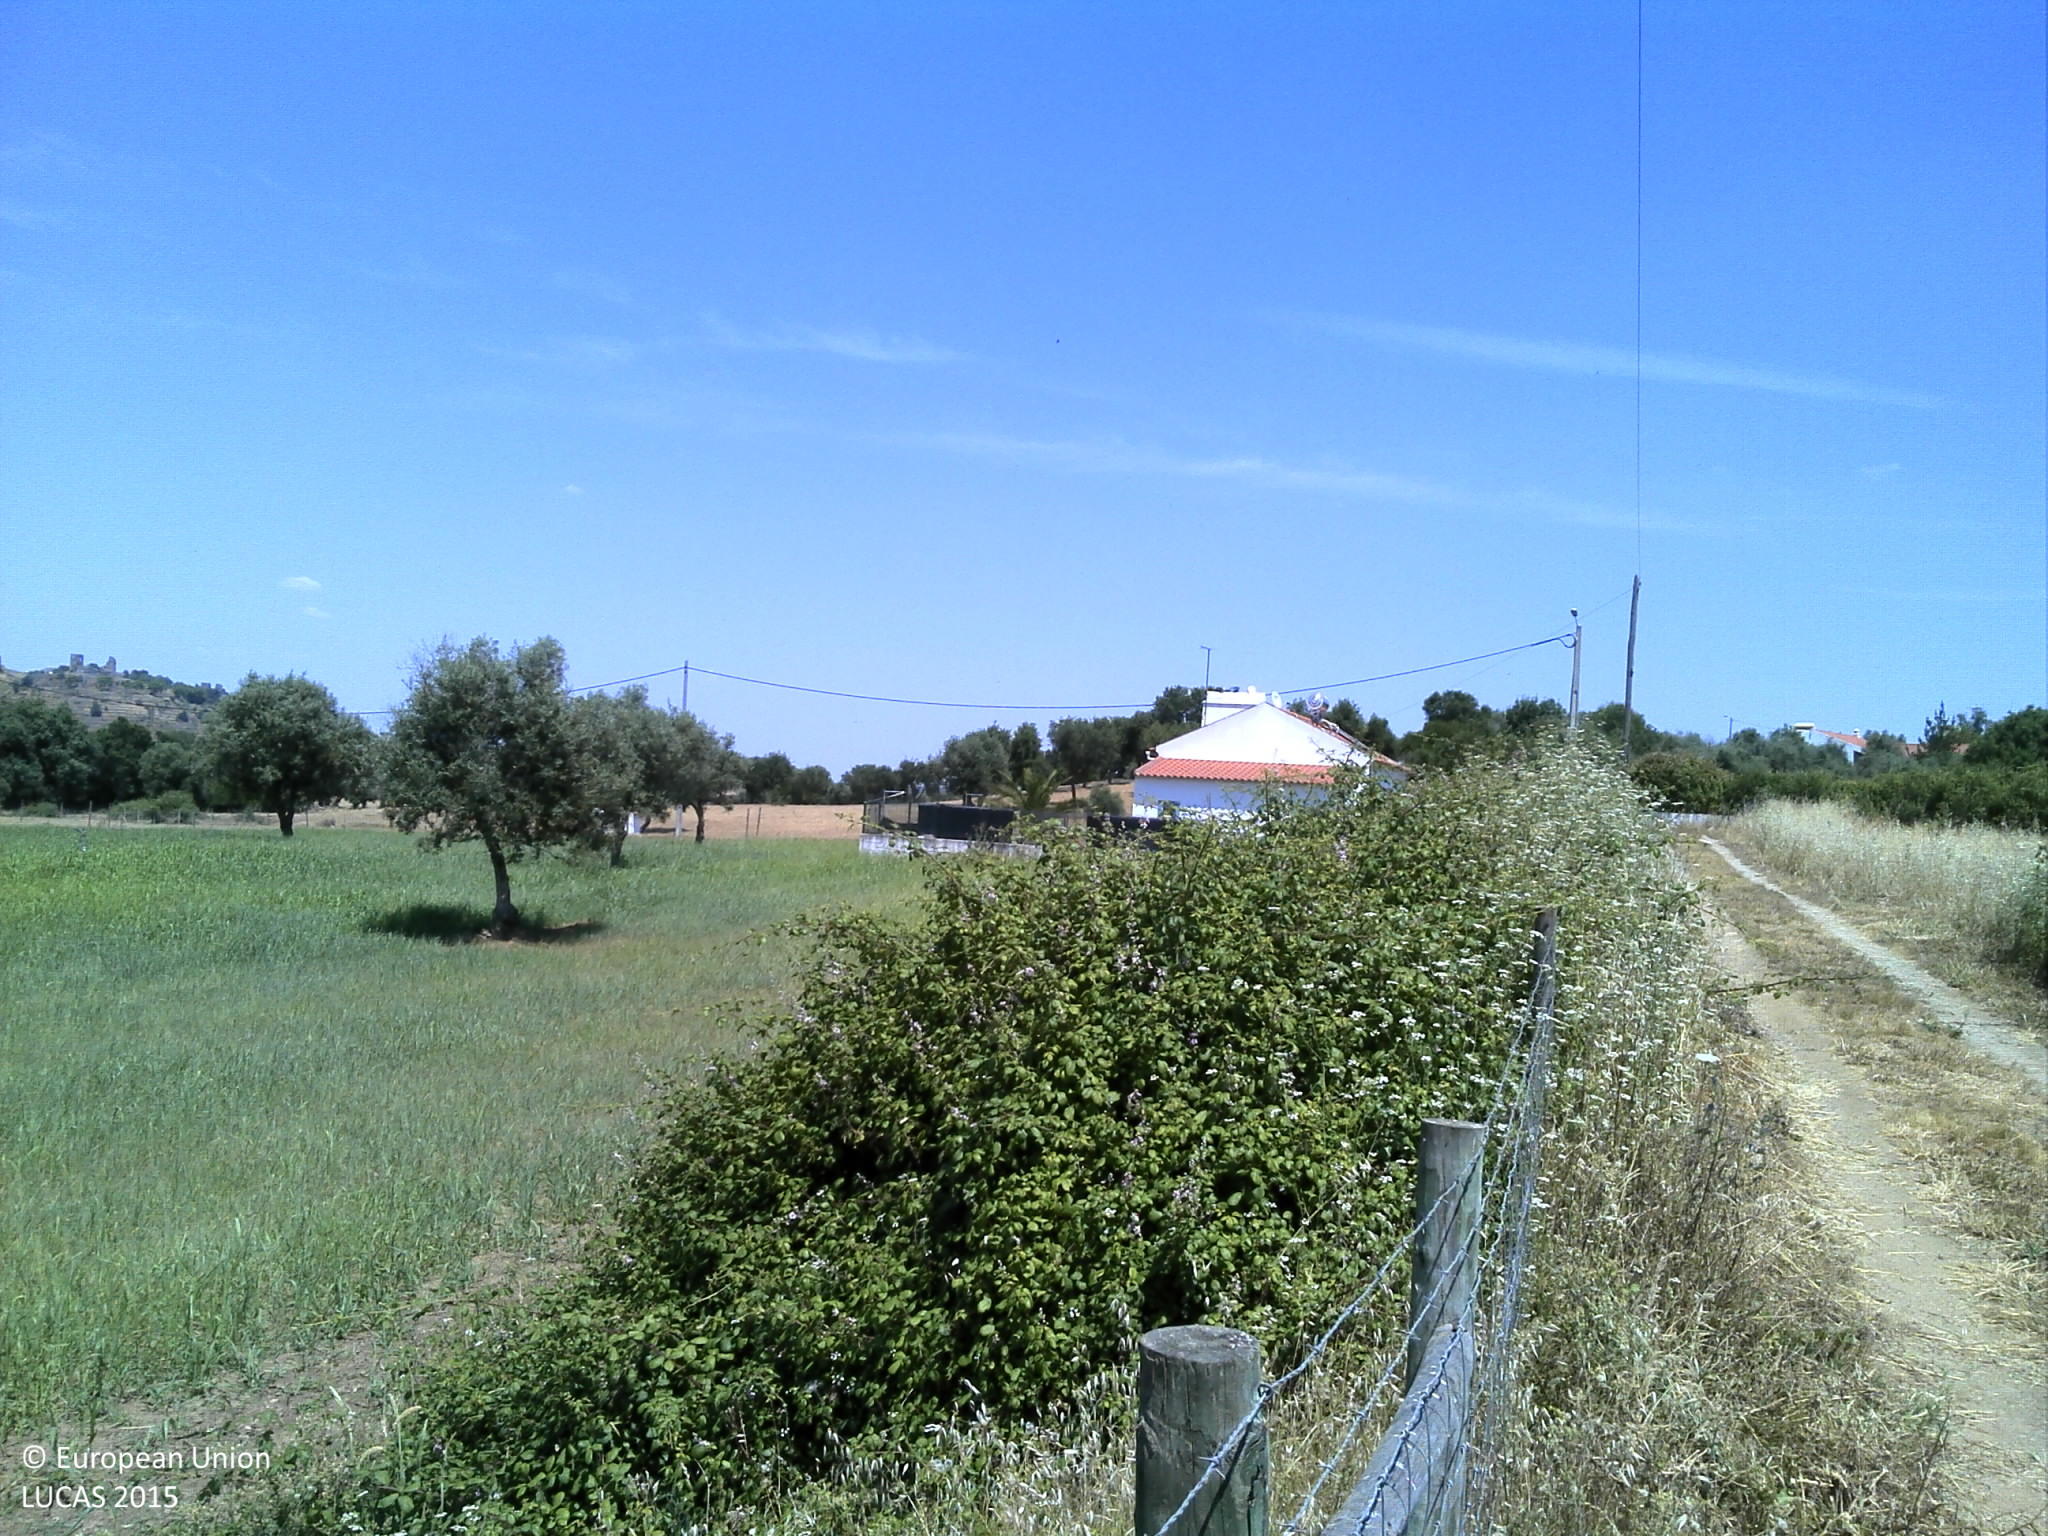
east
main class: Grassland
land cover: Spontaneously vegetated surfaces
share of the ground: < 10 %
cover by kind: unconsolidated bare surface 90 %, herbaceous plants 10 %
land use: Fallow land
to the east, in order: Spontaneously vegetated surfaces; Paved roads, cycling and walking lanes; Grass margins; Fences; Spontaneously vegetated surfaces; Arable land (only in case pi); Shruby margins; Rivers and streams; Shruby margins; Arable land (only in case pi); Broadleaved woodland
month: June
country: PT
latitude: 38.6346
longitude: -8.2341
